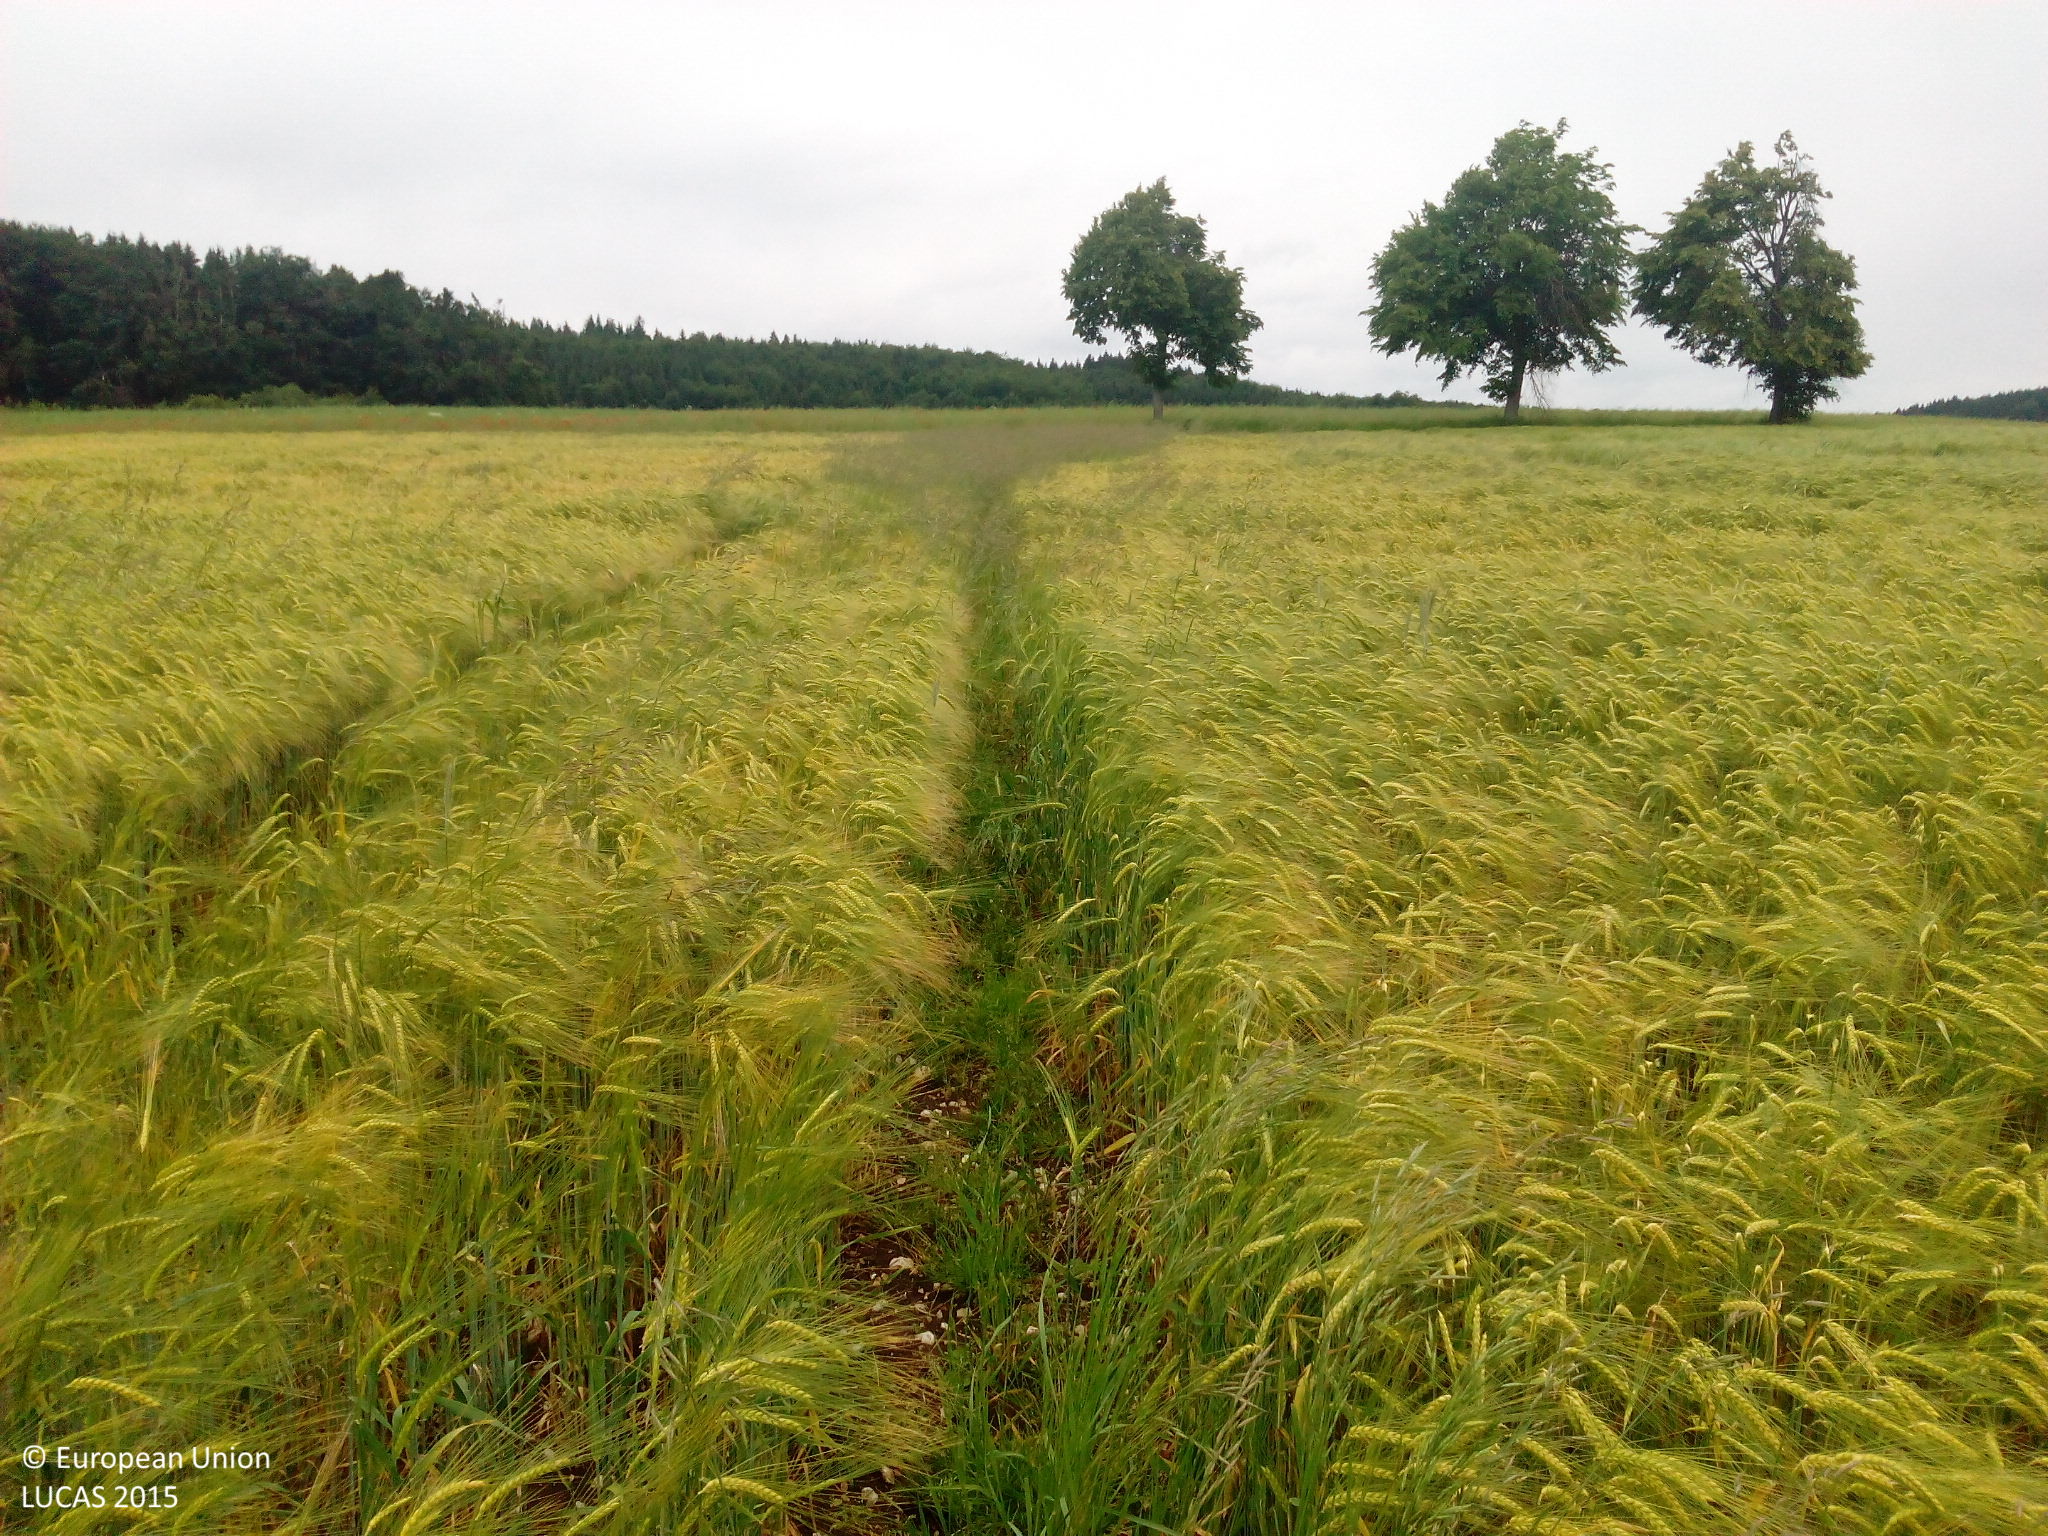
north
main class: Cropland
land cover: Barley
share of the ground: > 75 %
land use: Agriculture (excluding fallow land and kitchen gardens)
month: June
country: DE
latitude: 48.4748
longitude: 9.6079
